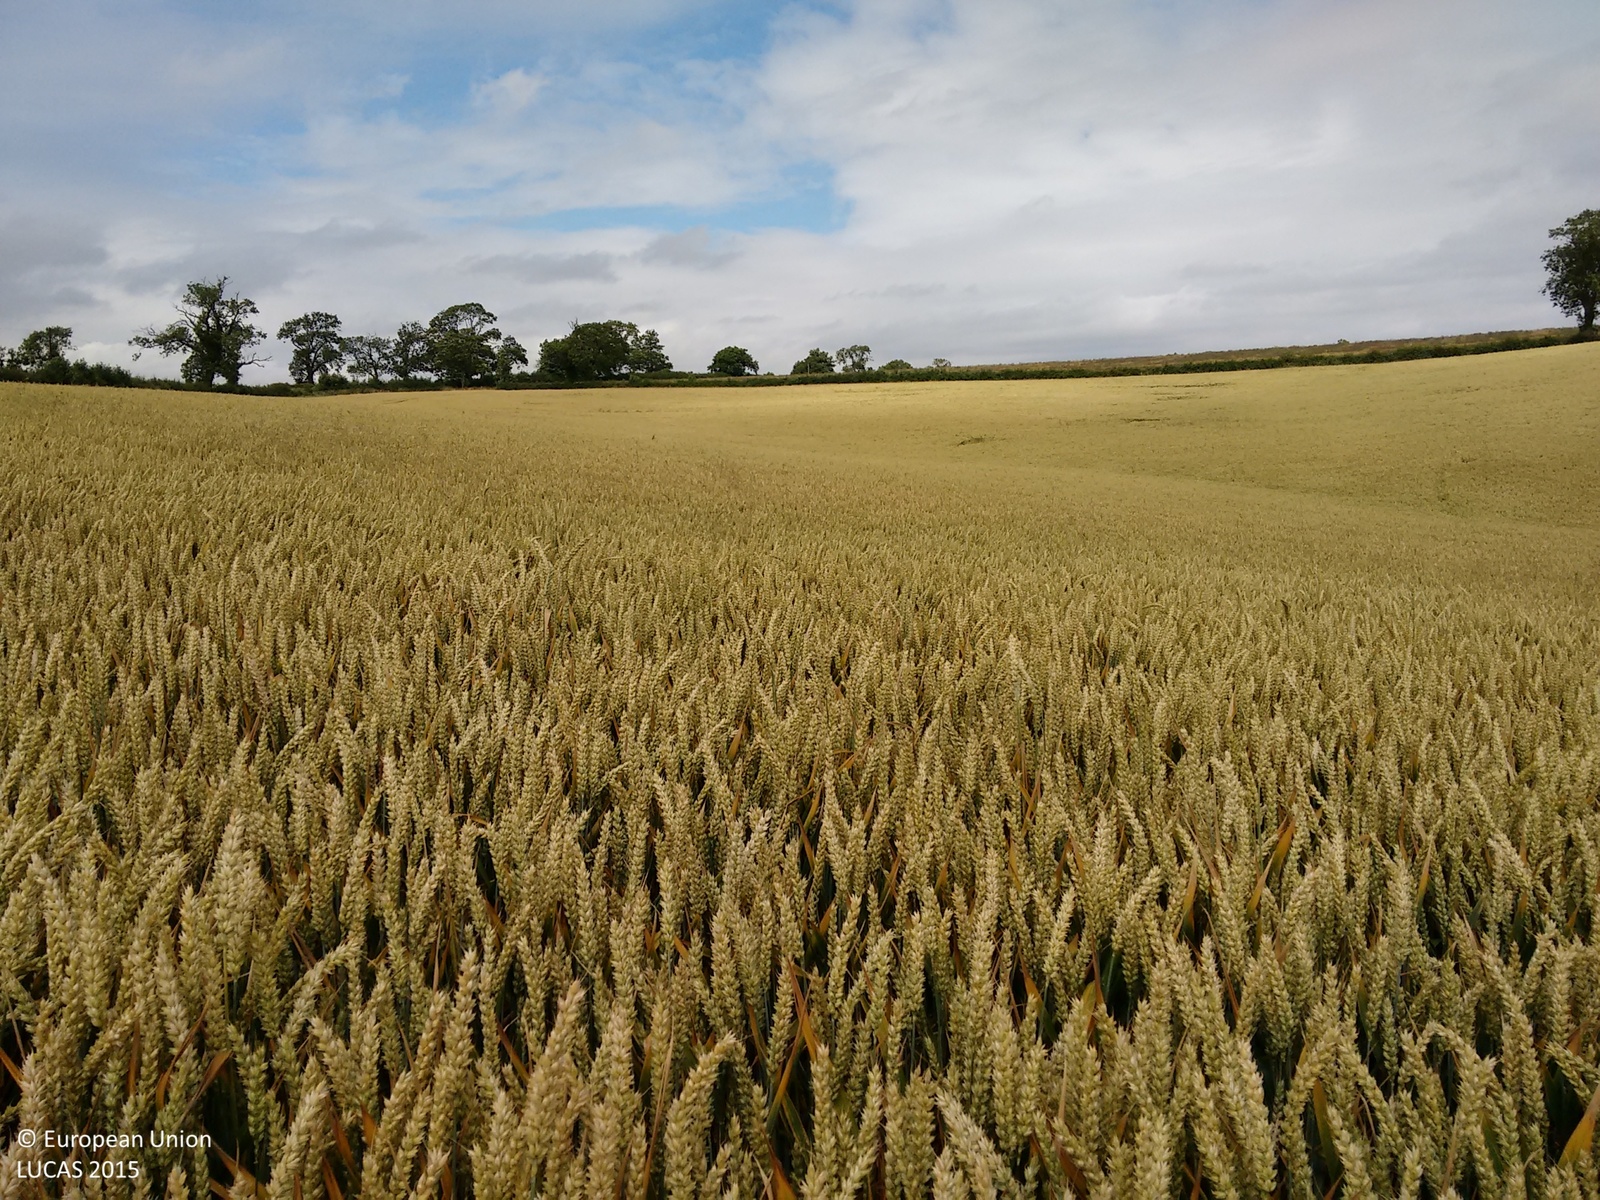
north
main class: Cropland
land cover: Common wheat
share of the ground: > 75 %
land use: Agriculture (excluding fallow land and kitchen gardens)
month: July
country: GB
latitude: 52.4584
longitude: -0.8593
